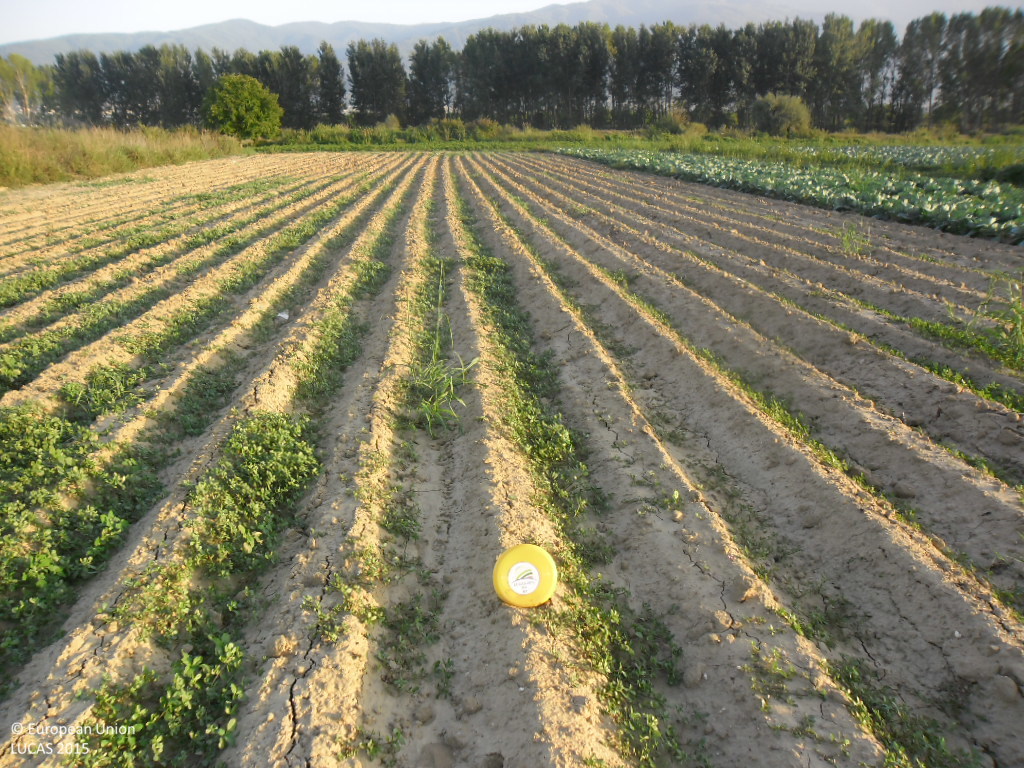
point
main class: Cropland
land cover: Potatoes
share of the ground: < 10 %
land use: Agriculture (excluding fallow land and kitchen gardens)
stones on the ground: < 10 %
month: September
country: BG
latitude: 41.4245
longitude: 23.1690
